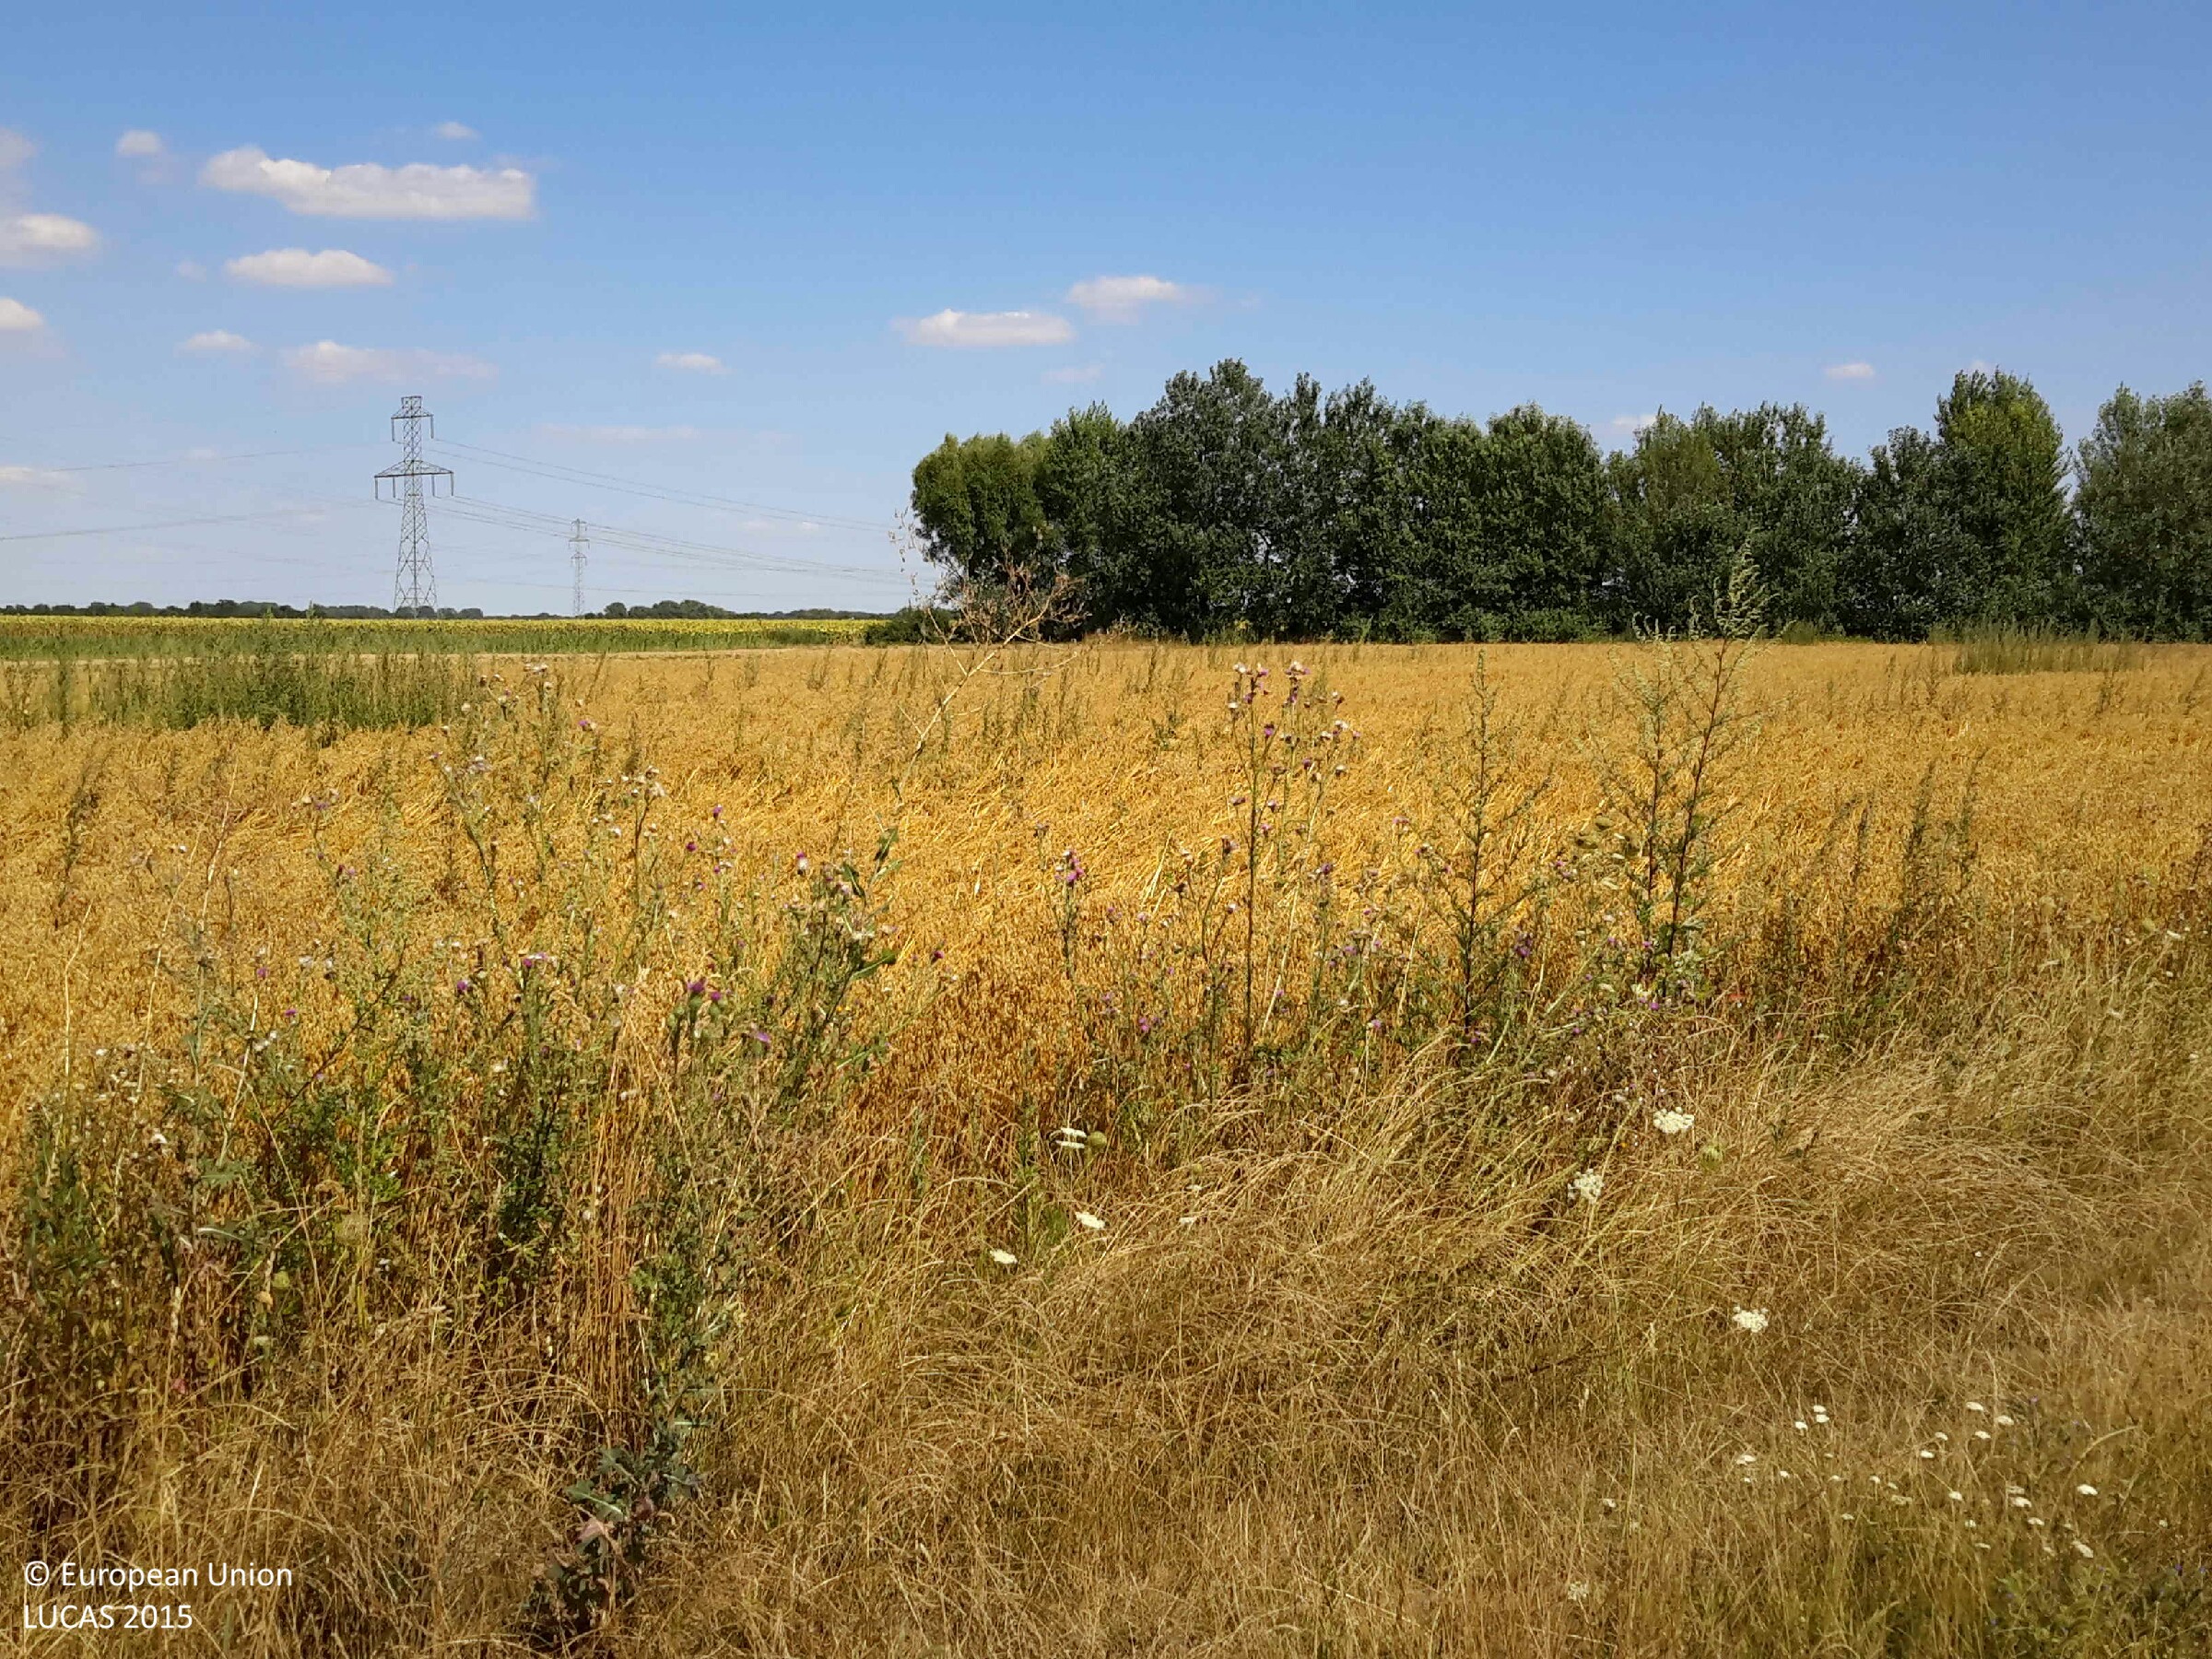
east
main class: Grassland
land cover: Grassland without tree/shrub cover
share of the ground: > 75 %
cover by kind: herbaceous plants 95 %, shrubs 5 %
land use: Agriculture (excluding fallow land and kitchen gardens)
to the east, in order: Grassland without tree/shrub cover; Fences; Grass margins; Tracks; Grass margins; Barley; Durum wheat; Grass margins; Tracks; Grass margins; Ditches and canals; Grass margins; Tracks; Grass margins; Ditches and canals; Grass margins; Tracks; Lines of trees; Sunflower
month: July
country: HU
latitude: 47.7373
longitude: 17.4361
